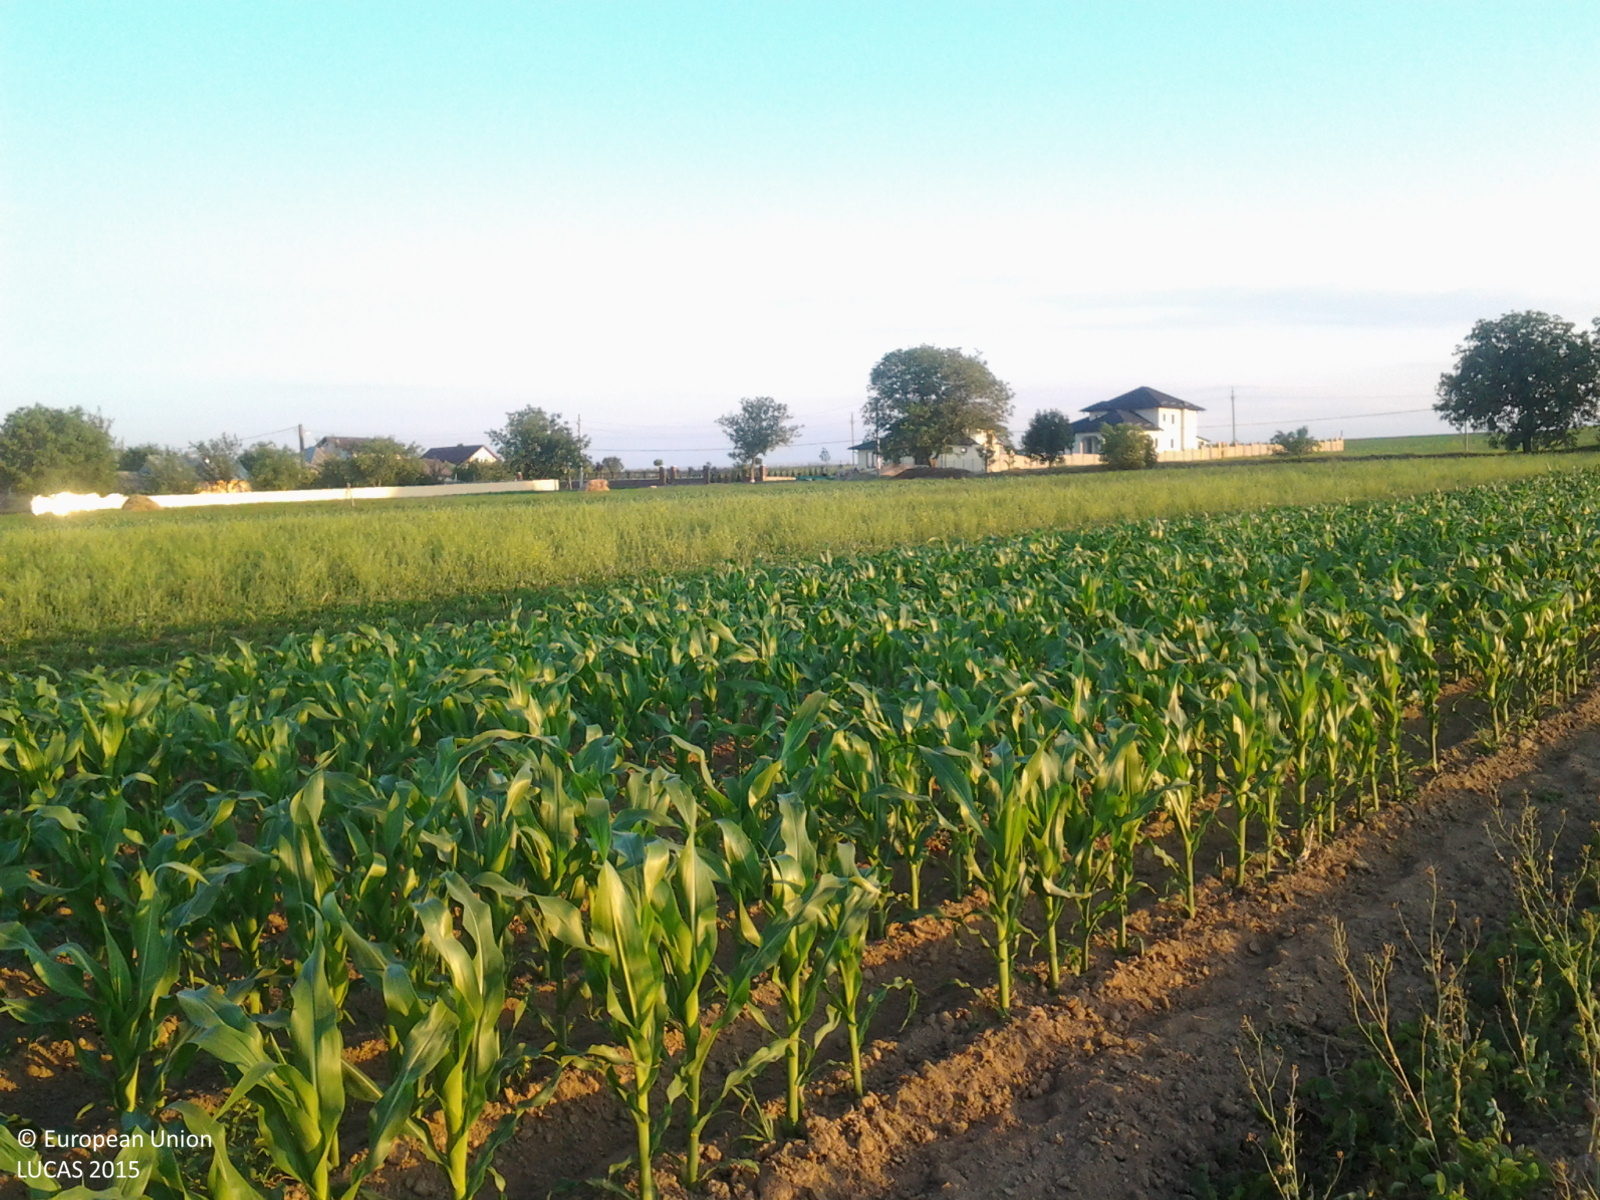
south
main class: Cropland
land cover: Soya
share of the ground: 25 - 50 %
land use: Agriculture (excluding fallow land and kitchen gardens)
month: June
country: RO
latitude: 47.7215
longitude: 26.5011
